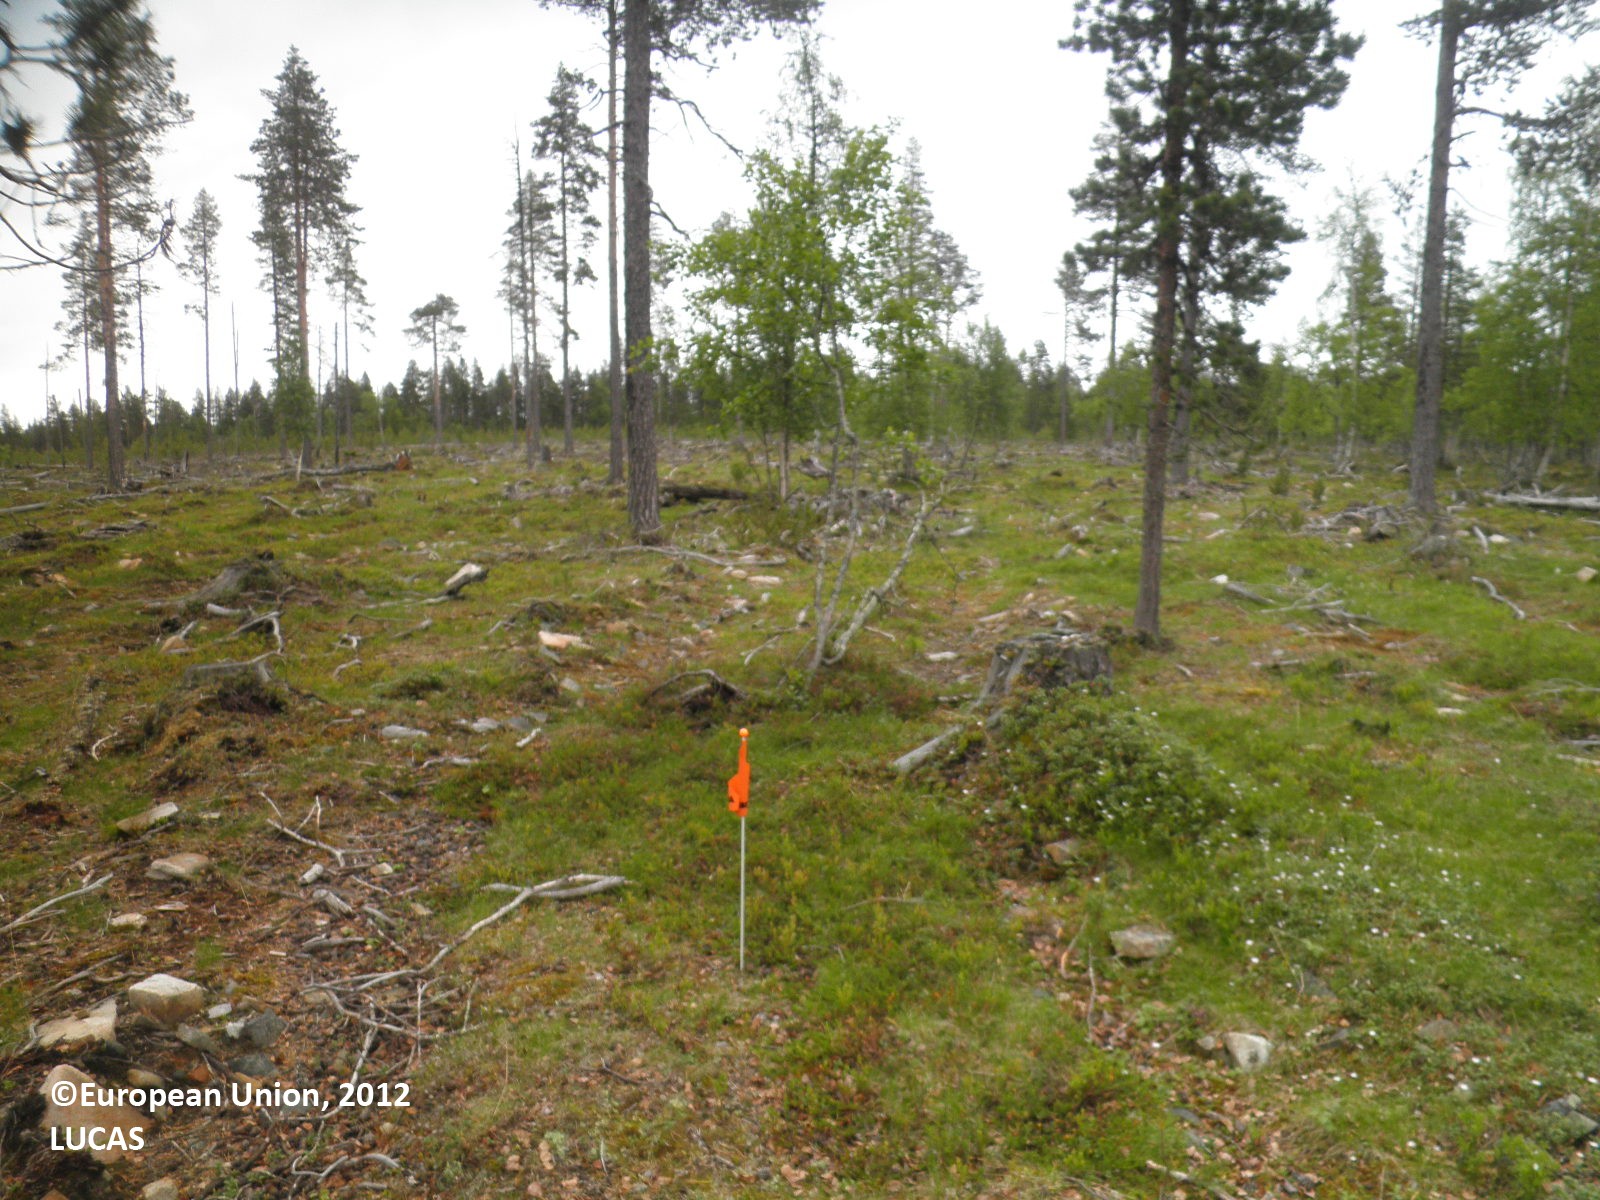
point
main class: Woodland
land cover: Pine dominated mixed woodland
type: boreal forest
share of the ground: 10 - 25 %
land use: Forestry
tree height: > 5 m
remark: Harvested field
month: July
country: FI
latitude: 68.4188
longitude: 25.8524
